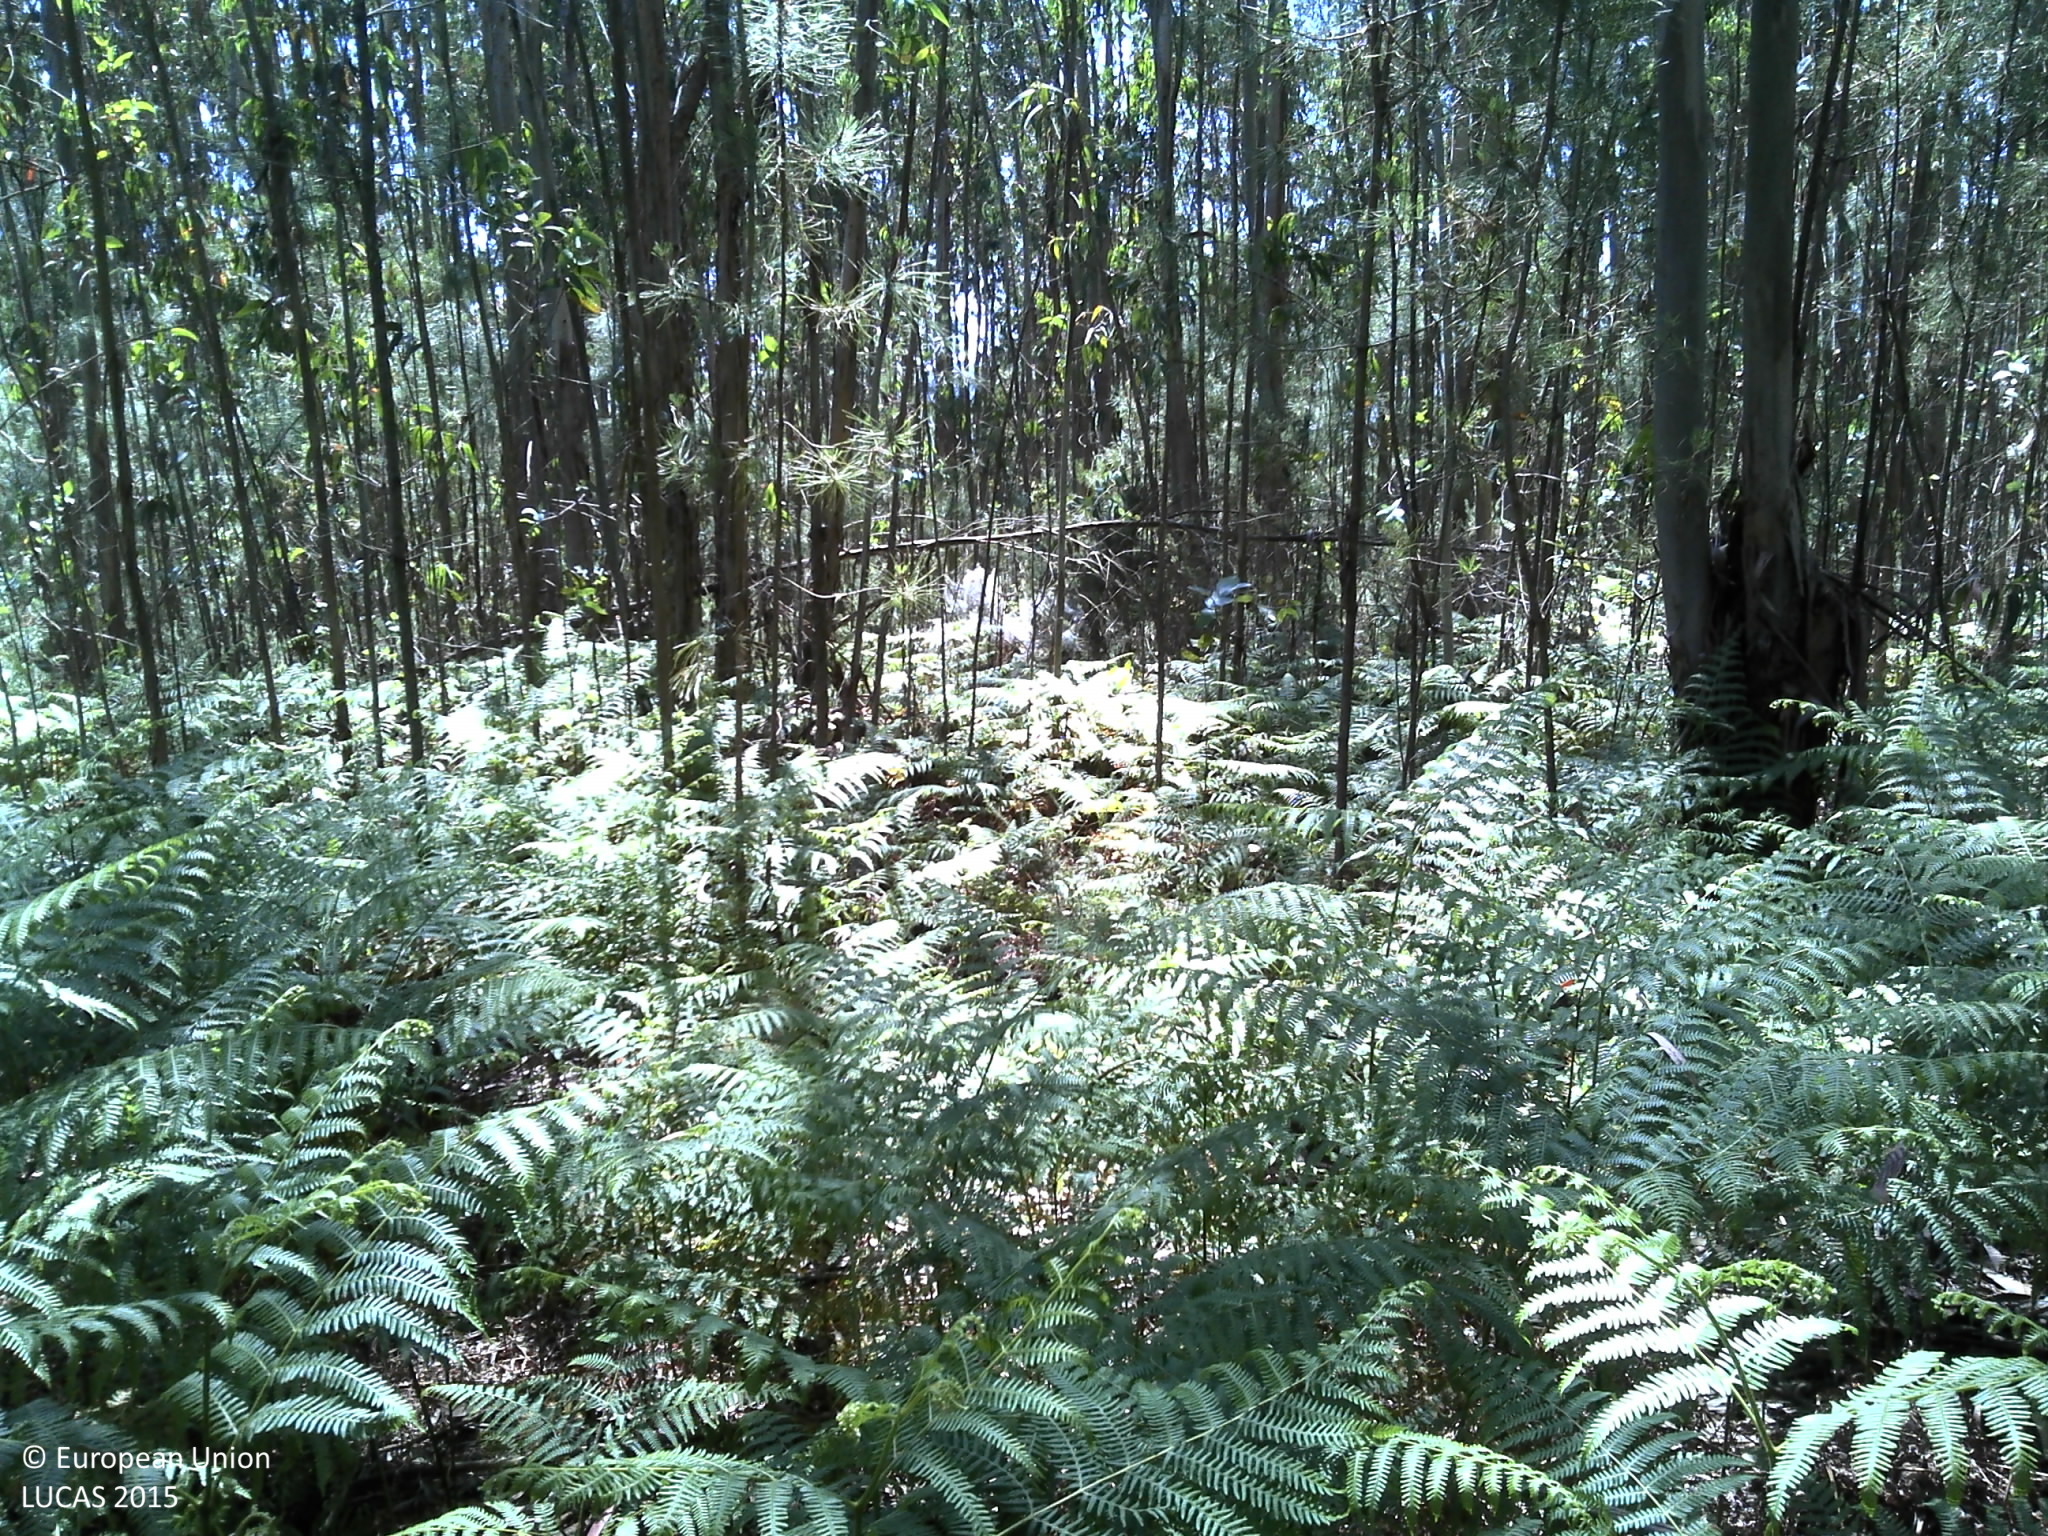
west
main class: Woodland
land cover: Broadleaved woodland
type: exotic forest
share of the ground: 50 - 75 %
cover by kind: broadleaved forest trees 65 %, shrubs 30 %, coniferous forest trees 5 %
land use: Forestry
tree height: > 5 m
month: May
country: PT
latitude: 41.6713
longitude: -8.5982
